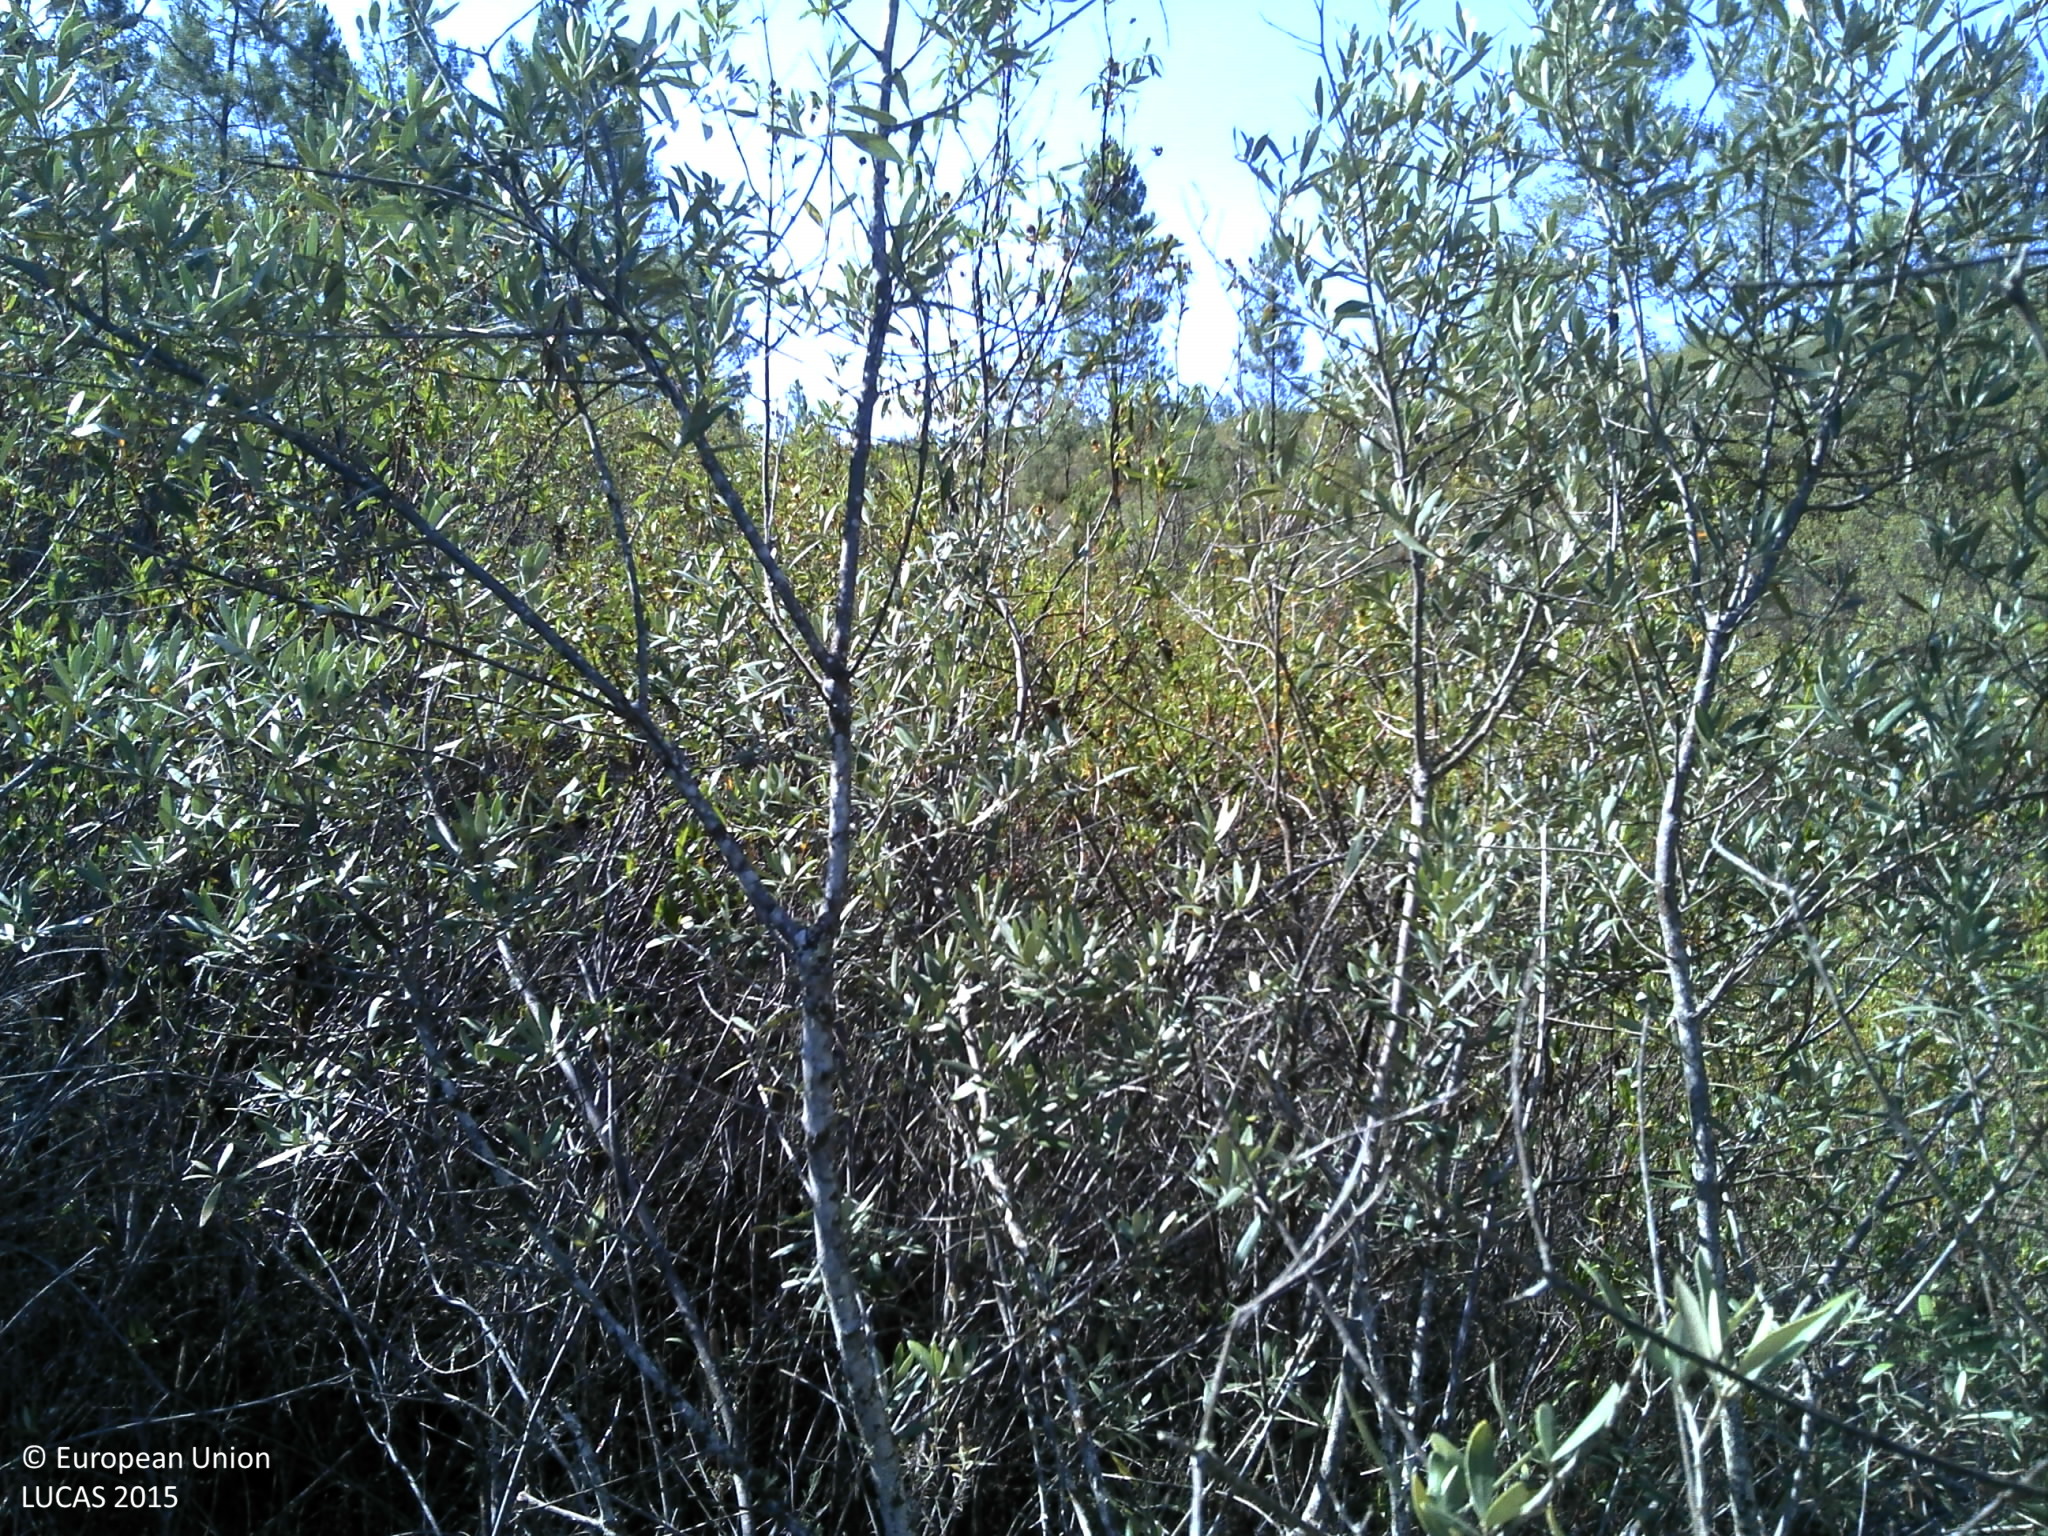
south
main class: Shrubland
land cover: Shrubland with sparse tree cover
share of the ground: 50 - 75 %
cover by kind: shrubs 60 %, unconsolidated bare surface 35 %, coniferous forest trees 5 %
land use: Semi-natural and natural areas not in use
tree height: < 5 m
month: July
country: PT
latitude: 39.5095
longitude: -7.9100
